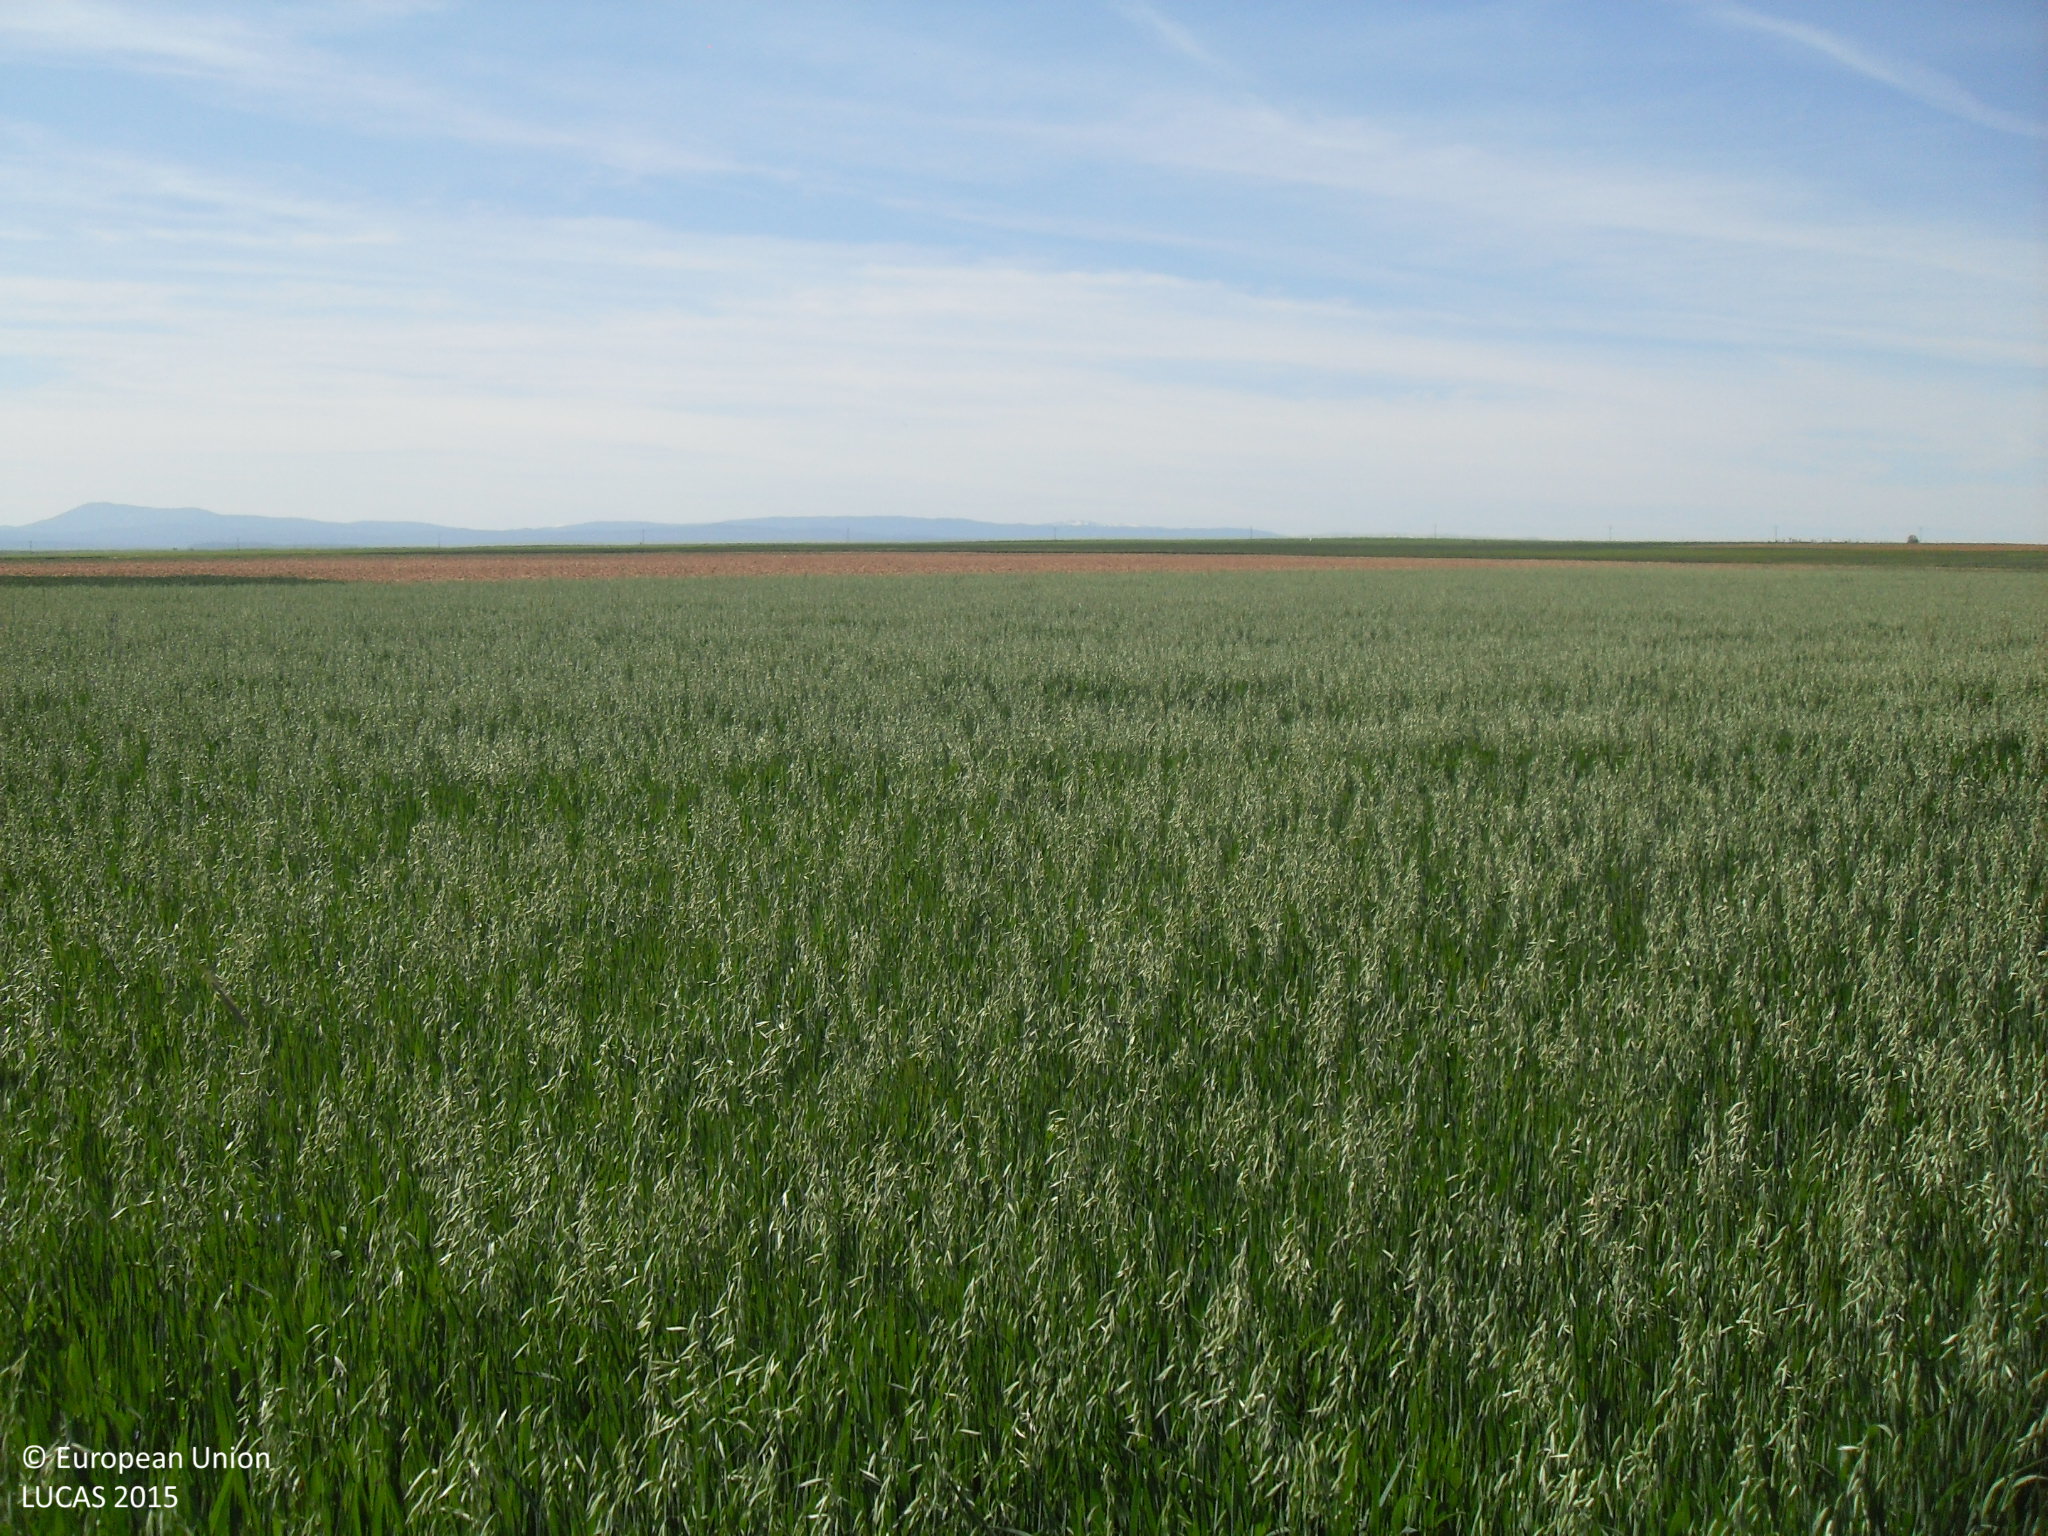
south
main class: Cropland
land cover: Oats
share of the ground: > 75 %
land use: Agriculture (excluding fallow land and kitchen gardens)
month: May
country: ES
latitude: 40.8929
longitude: -5.3217
